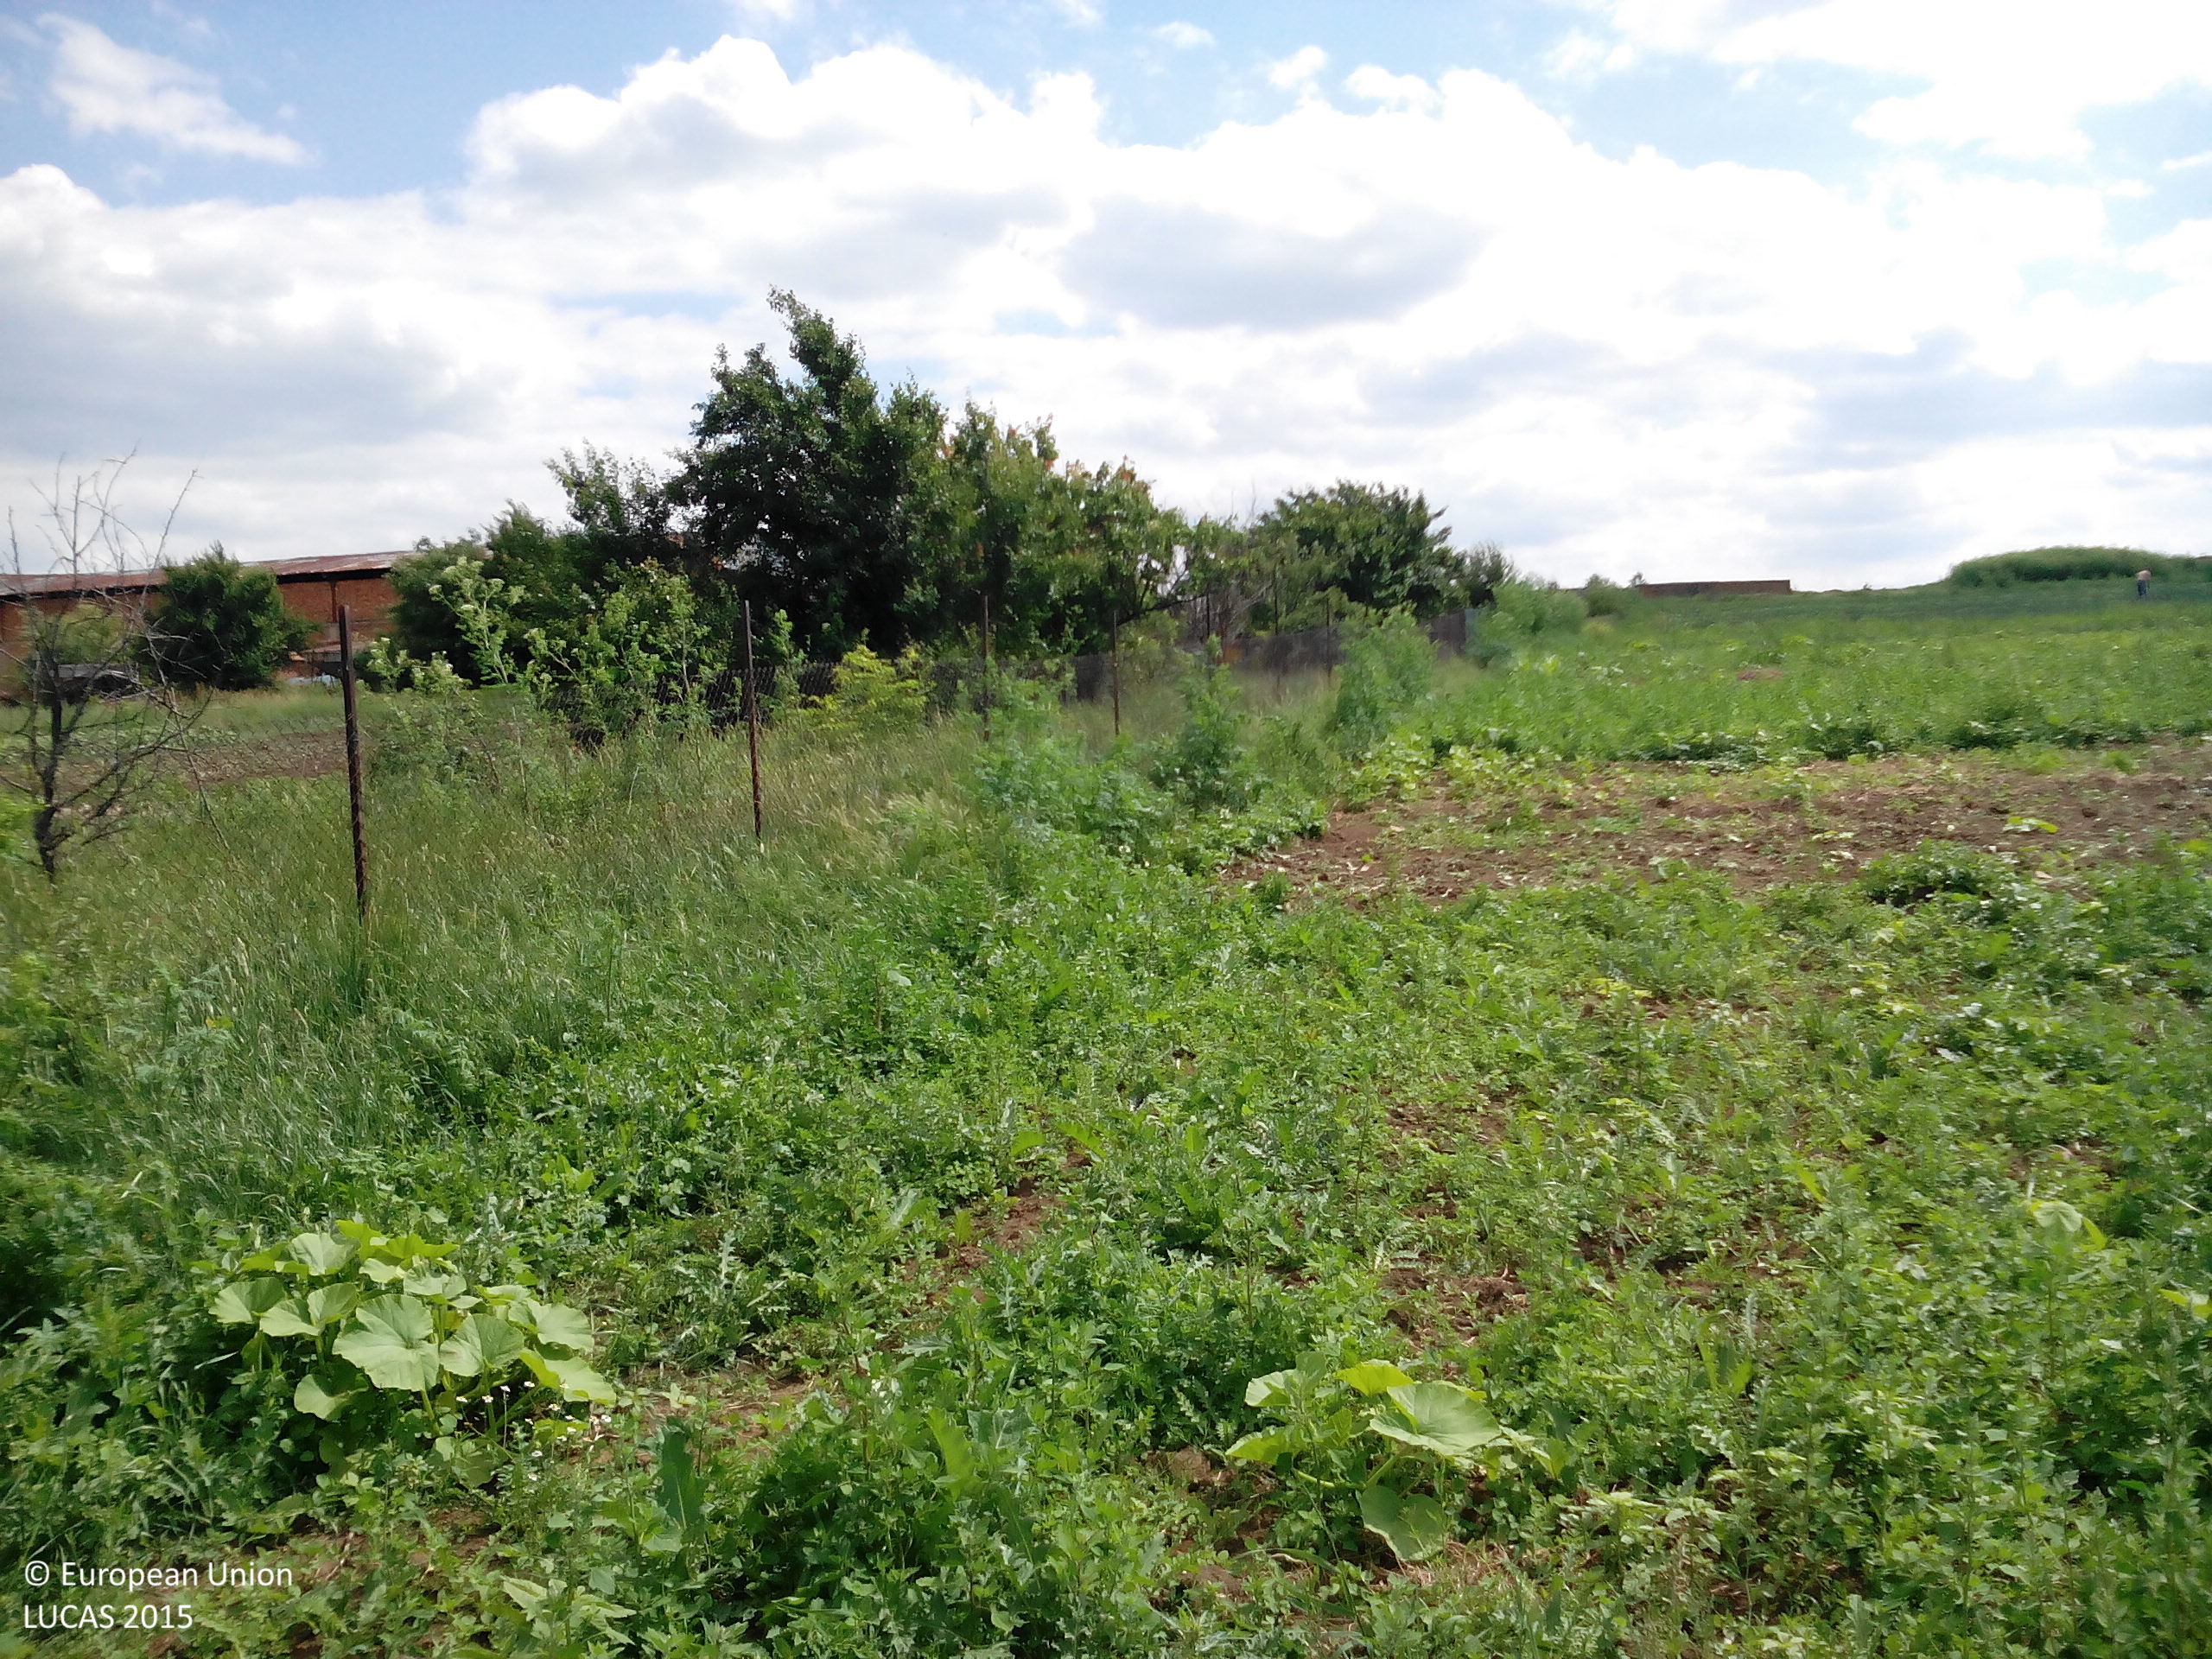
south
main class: Cropland
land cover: Cherry fruit
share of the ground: > 75 %
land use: Kitchen garden
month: May
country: BG
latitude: 43.5058
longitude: 23.8664
